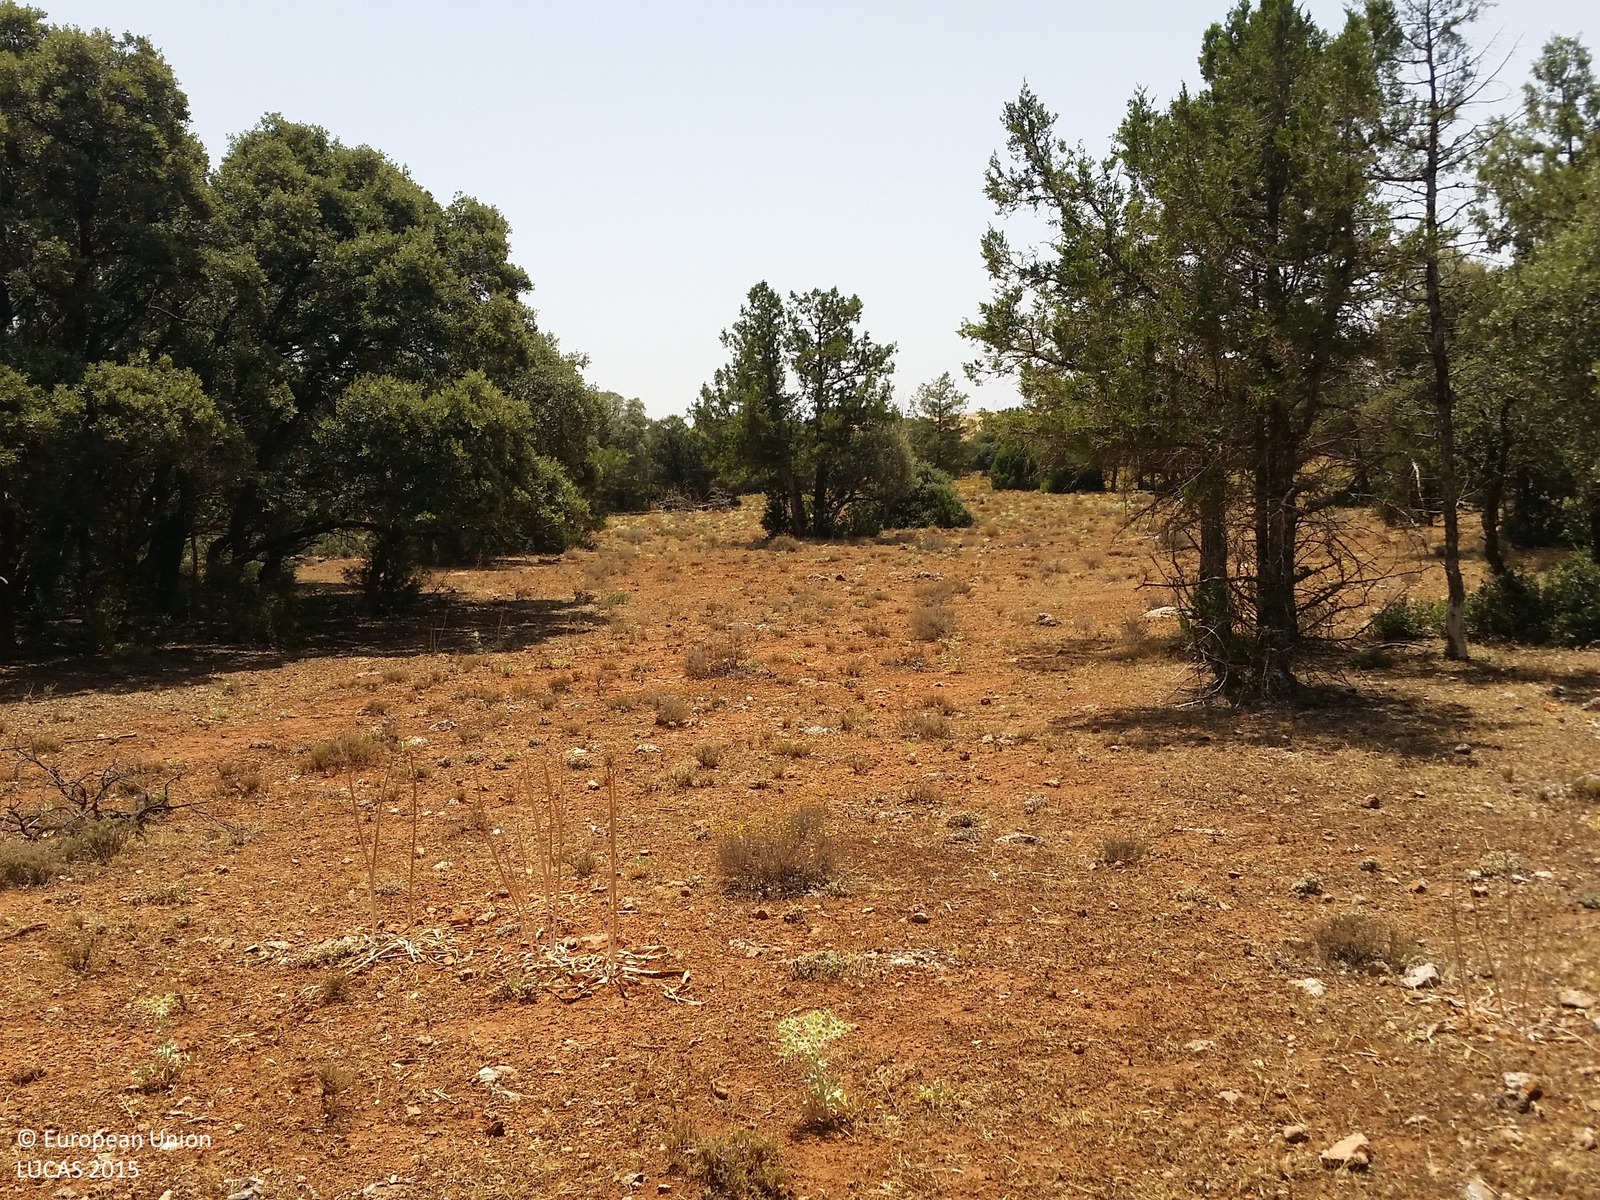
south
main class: Woodland
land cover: Pine dominated mixed woodland
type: coniferous forest of the mediterranean region
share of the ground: > 75 %
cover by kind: shrubs 30 %, coniferous forest trees 25 %, herbaceous plants 20 %, broadleaved forest trees 15 %, consolidated bare surface 10 %
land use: Semi-natural and natural areas not in use
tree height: > 5 m
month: June
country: ES
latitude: 38.8062
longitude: -2.4972
